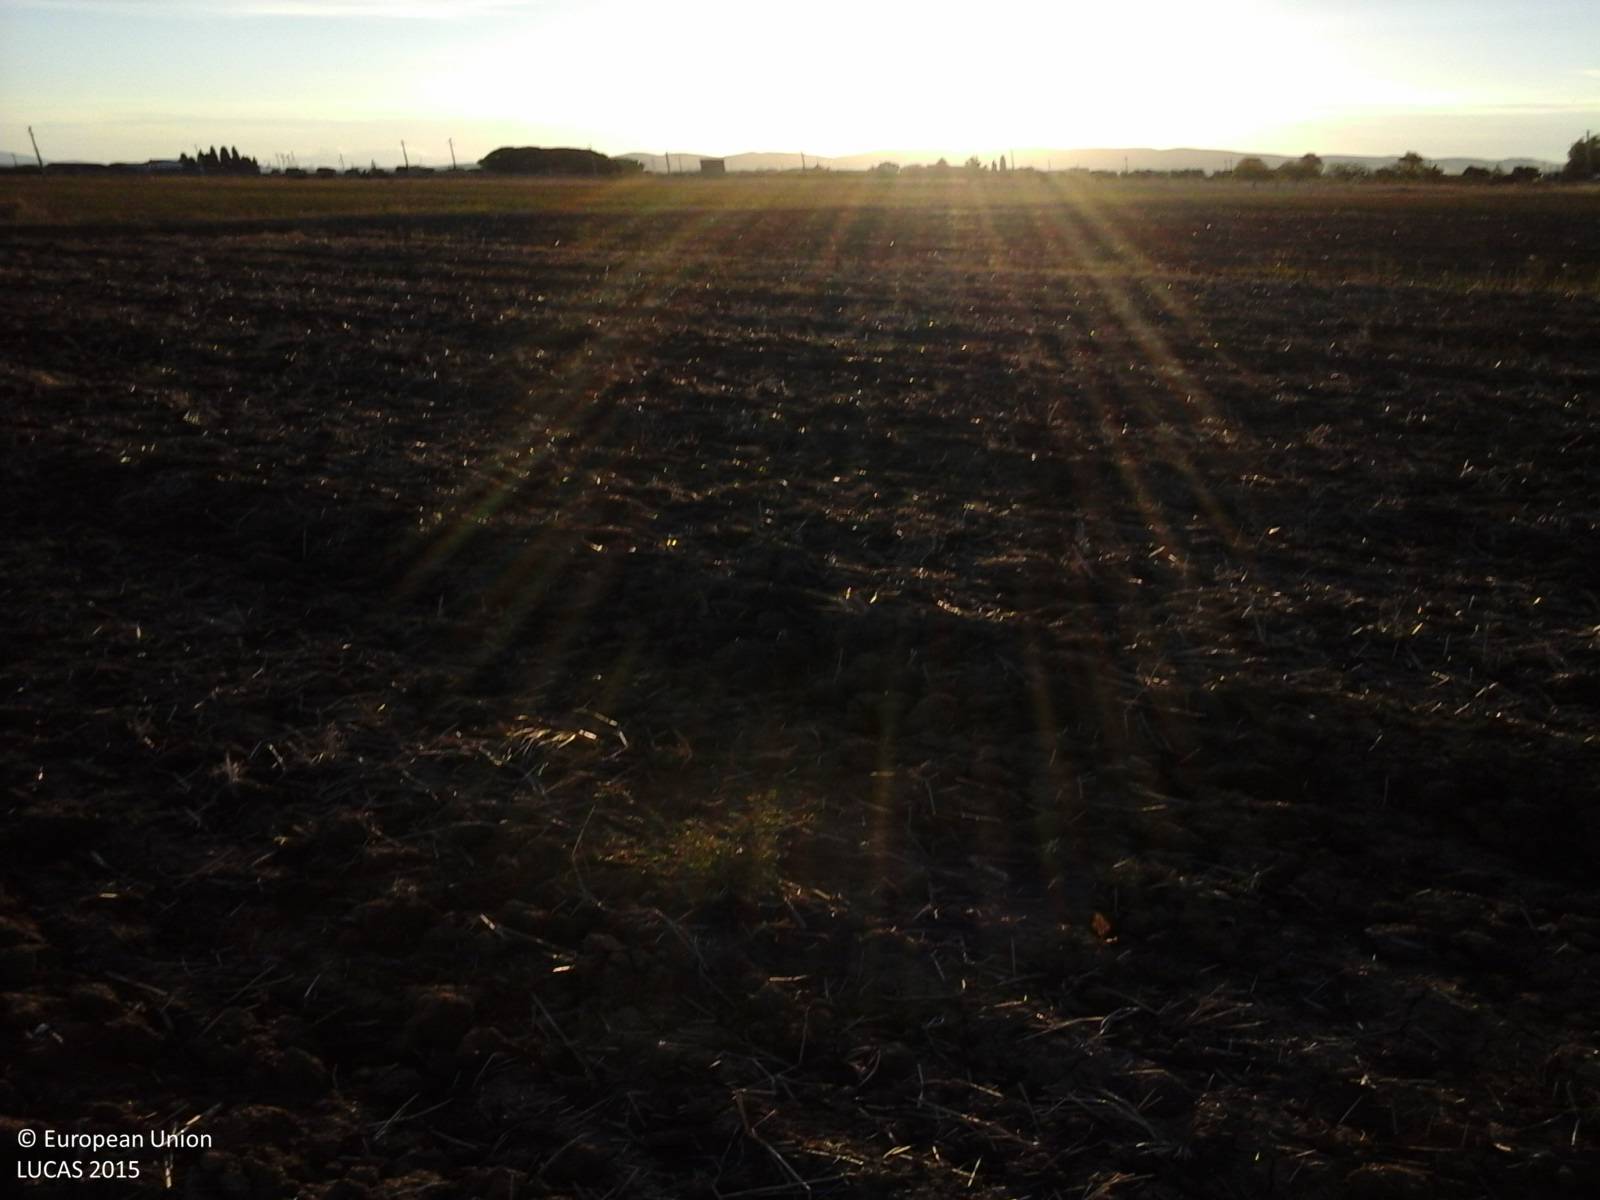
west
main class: Cropland
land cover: Durum wheat
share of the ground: < 10 %
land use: Agriculture (excluding fallow land and kitchen gardens)
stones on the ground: < 10 %
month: October
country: IT
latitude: 42.9772
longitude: 10.6234
